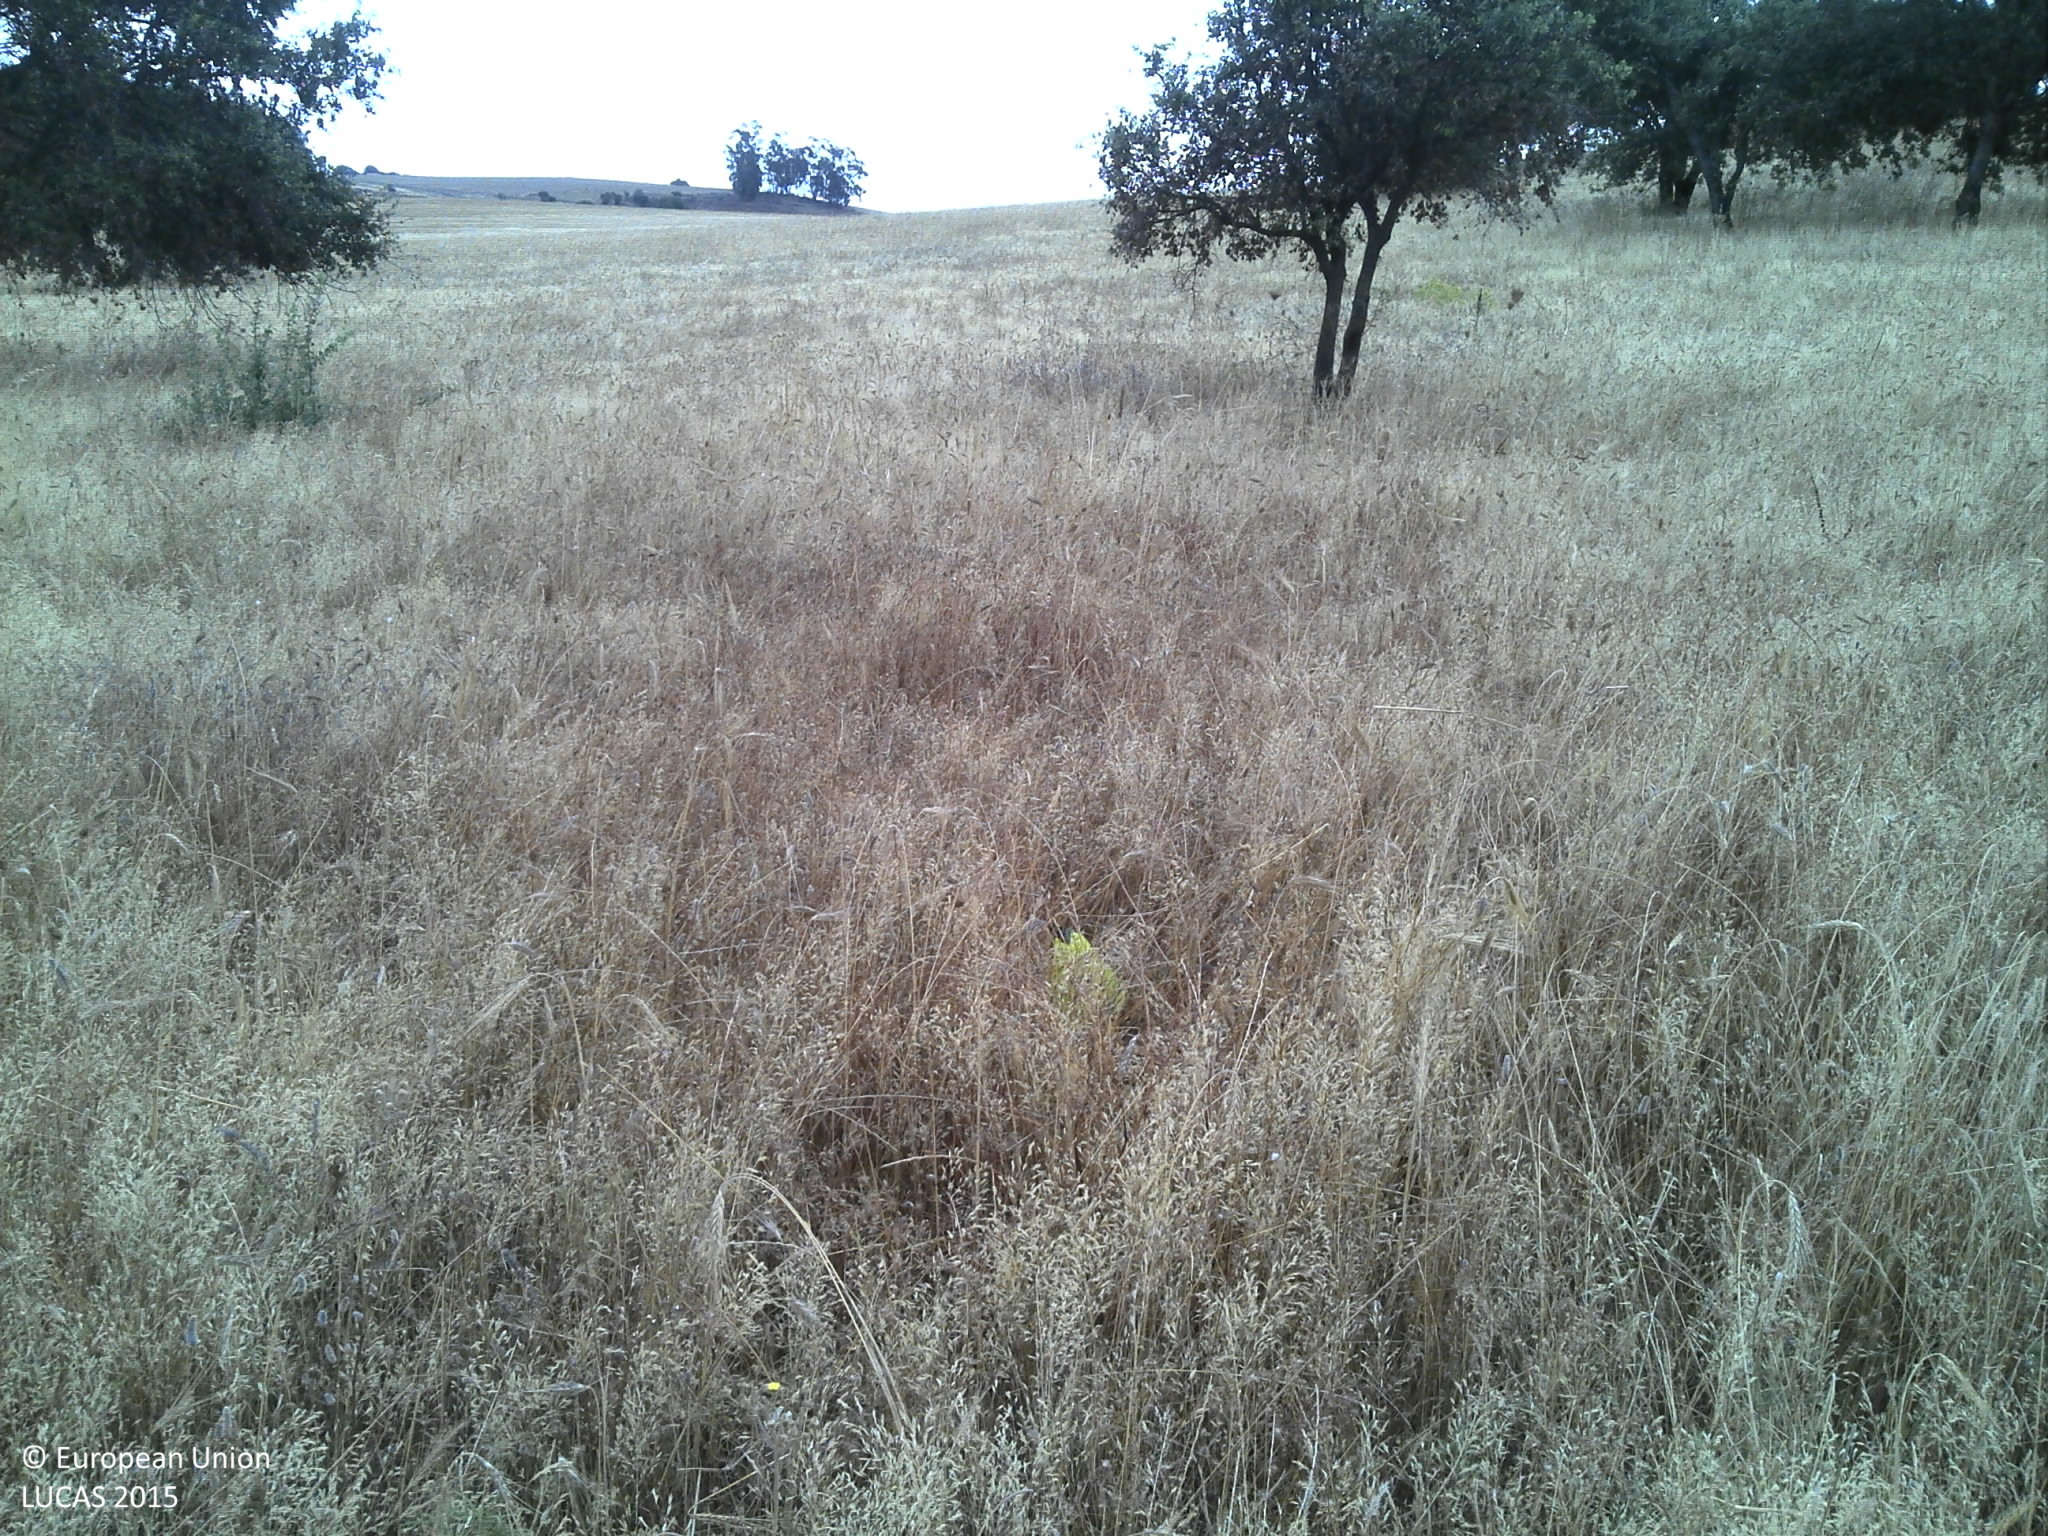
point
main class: Grassland
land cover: Grassland with sparse tree/shrub cover
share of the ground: > 75 %
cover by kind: herbaceous plants 80 %, unconsolidated bare surface 15 %, broadleaved forest trees 5 %
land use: Agriculture (excluding fallow land and kitchen gardens)
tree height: < 5 m
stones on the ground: < 10 %
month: July
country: PT
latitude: 38.8526
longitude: -7.4684
